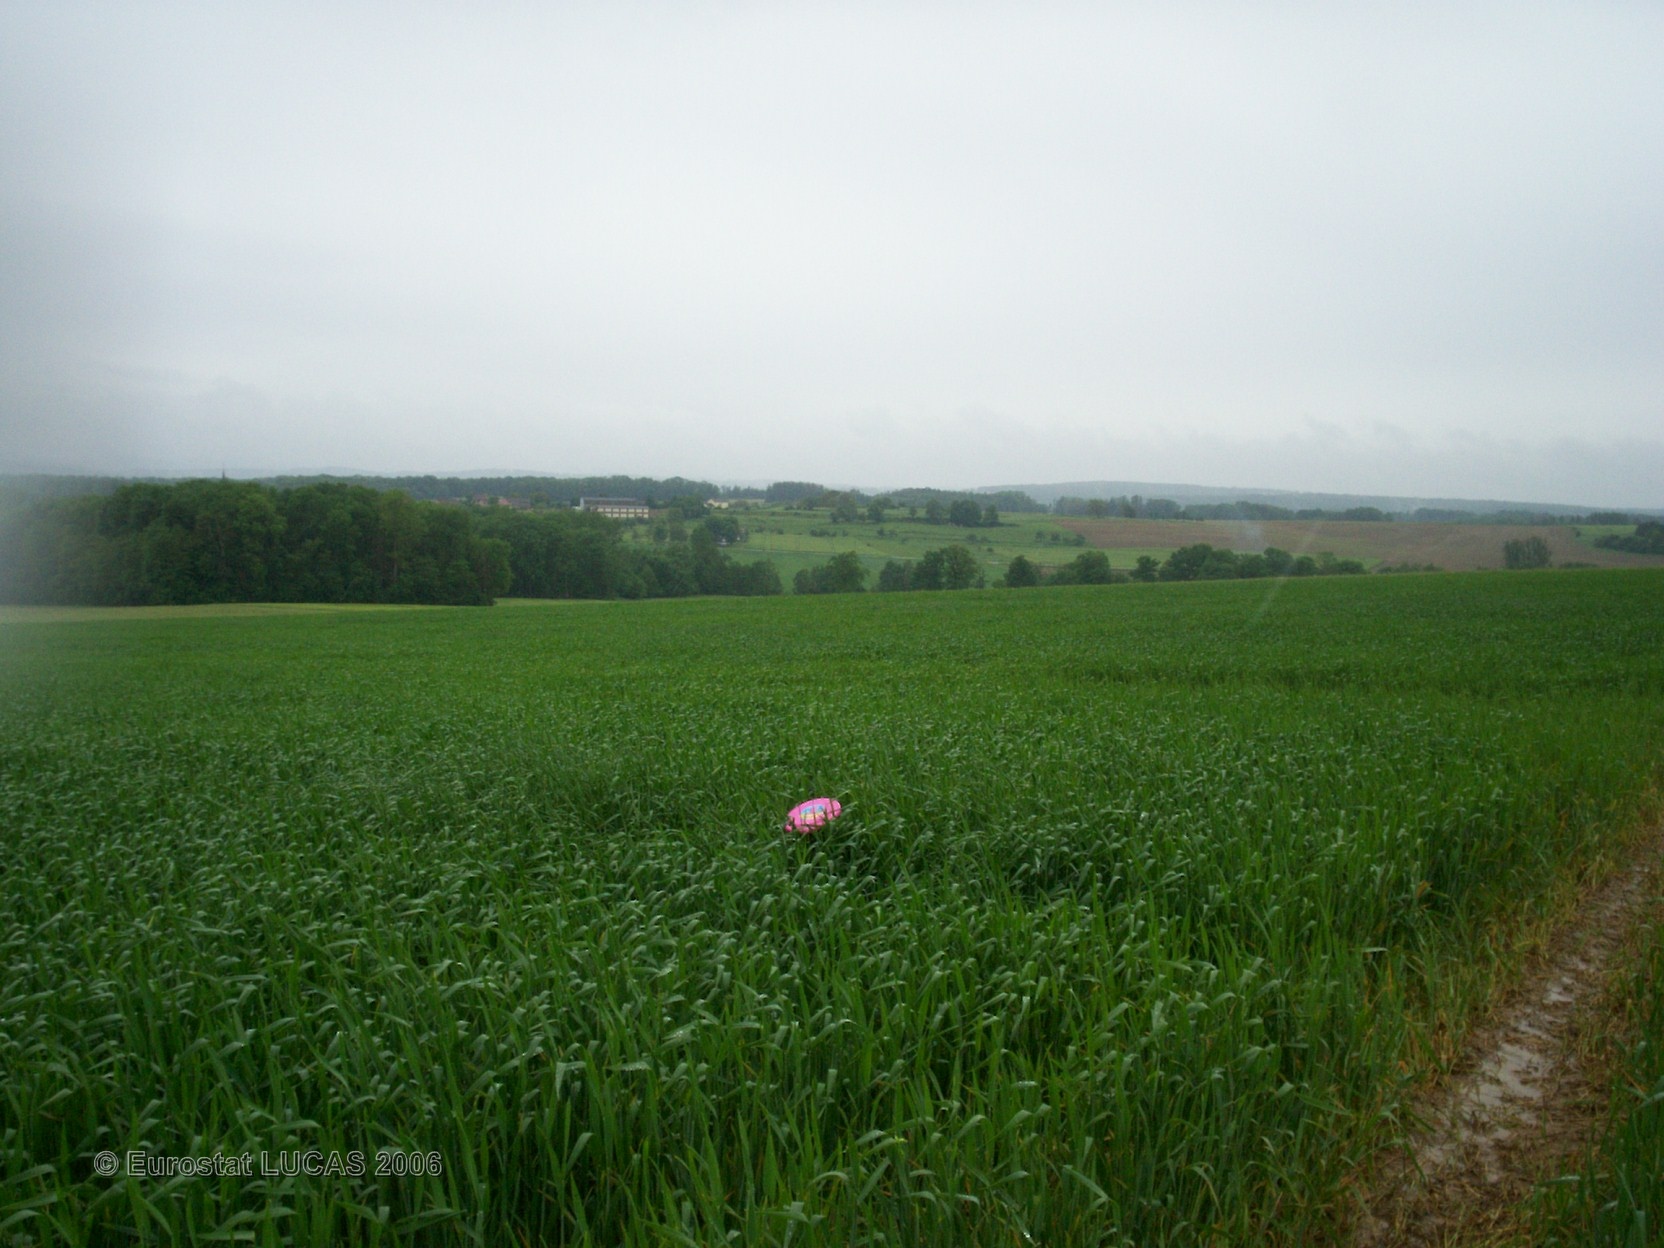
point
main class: Cropland
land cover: Barley
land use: Agriculture (excluding fallow land and kitchen gardens)
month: May
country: FR
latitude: 48.5198
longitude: 6.8190
